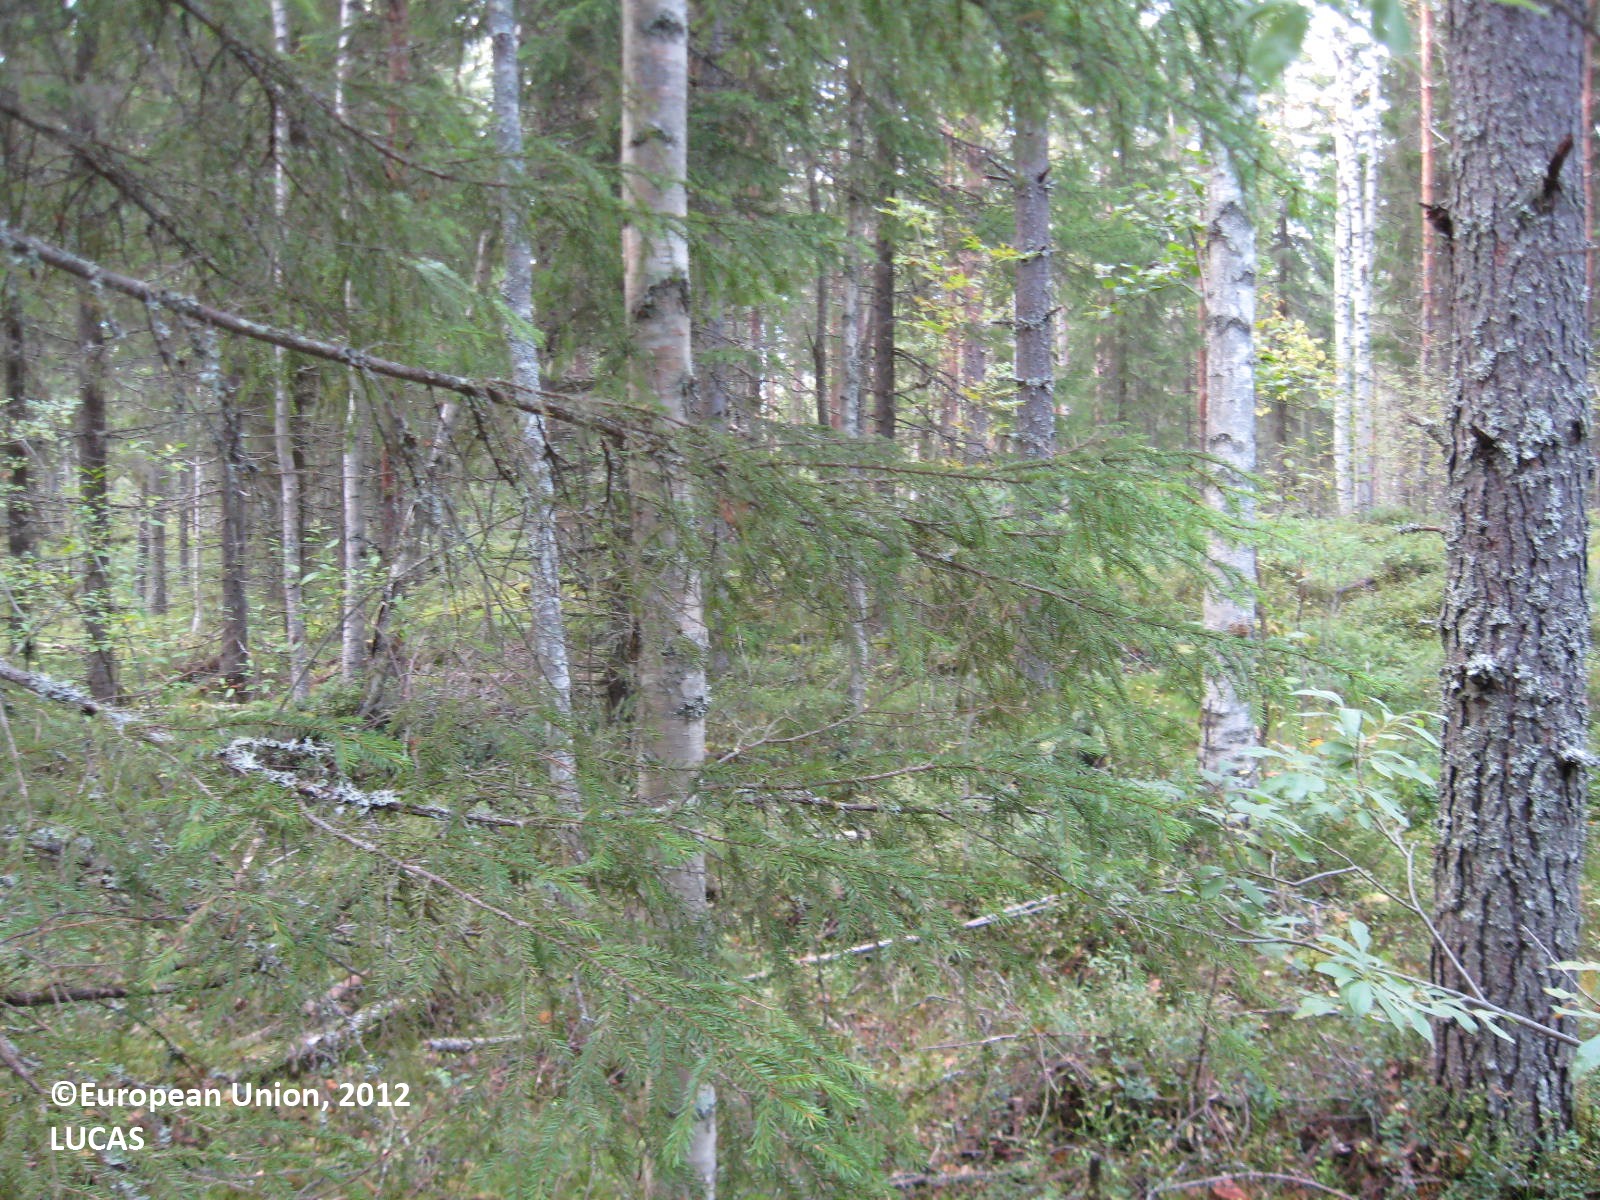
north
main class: Woodland
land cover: Spruce dominated mixed woodland
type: boreal forest
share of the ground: > 75 %
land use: Forestry
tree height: > 5 m
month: August
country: FI
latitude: 63.7319
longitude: 29.4832
